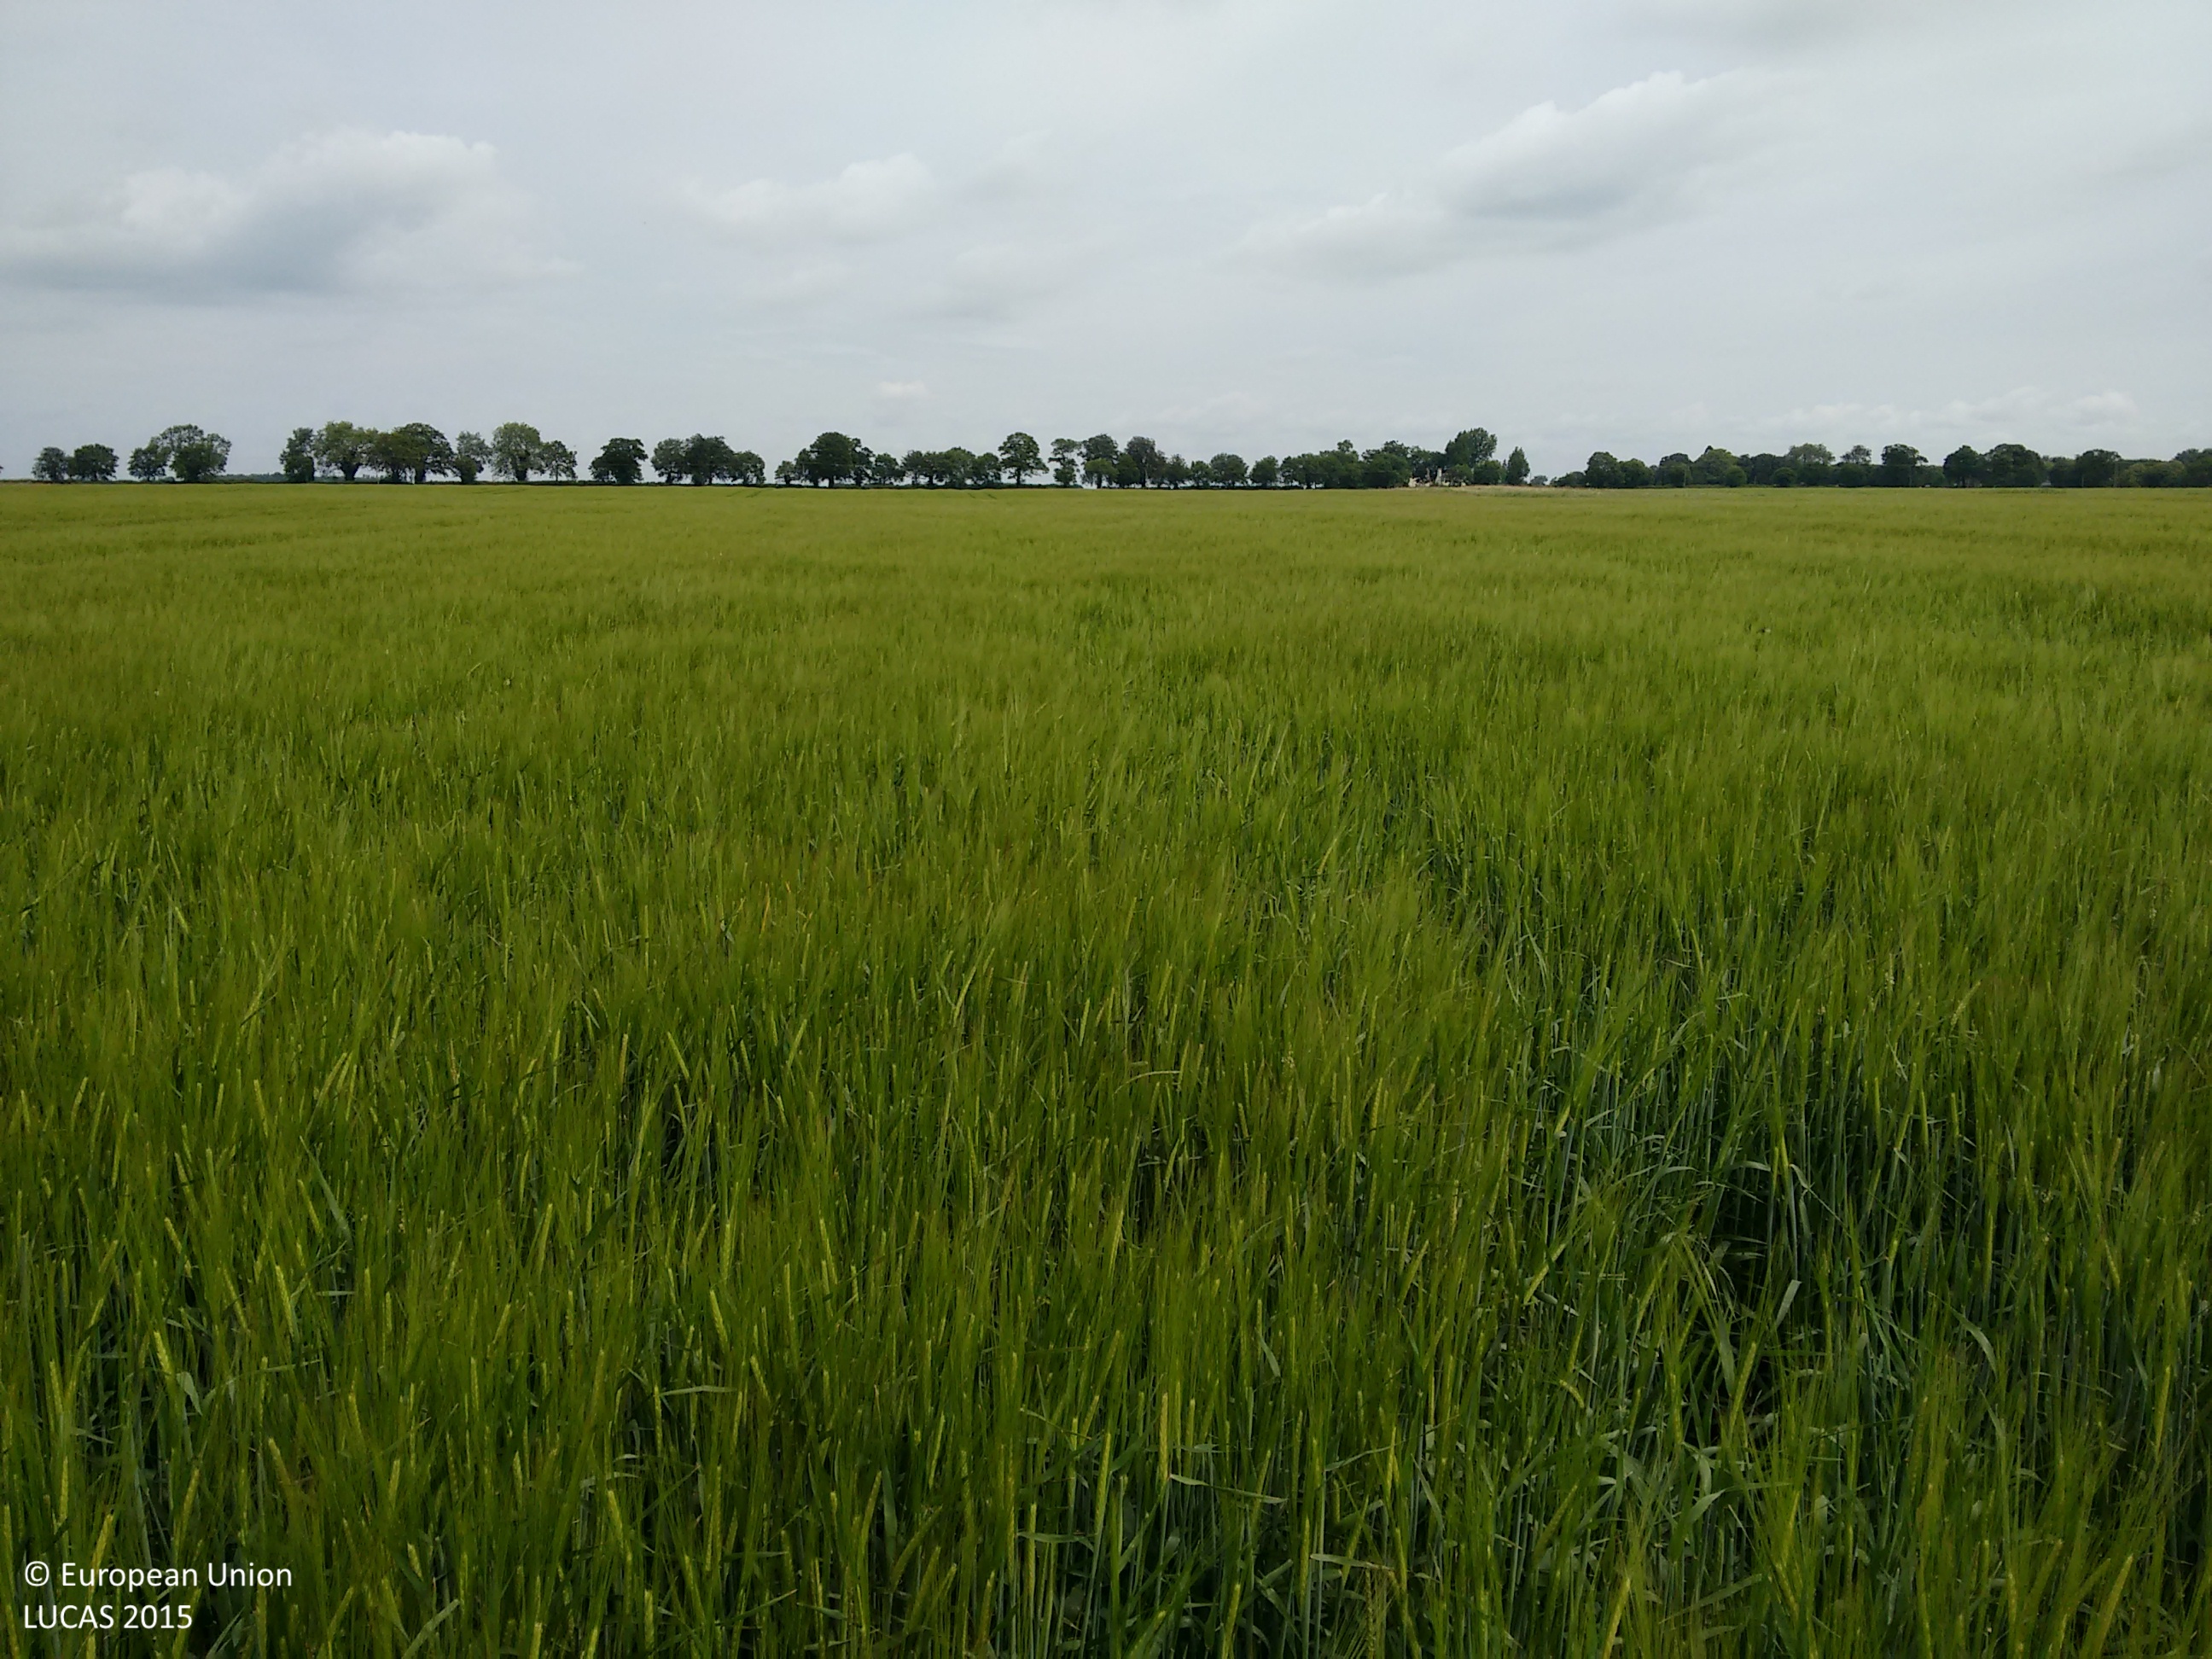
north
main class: Cropland
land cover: Barley
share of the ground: > 75 %
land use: Agriculture (excluding fallow land and kitchen gardens)
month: June
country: GB
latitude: 52.6371
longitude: -0.0666
